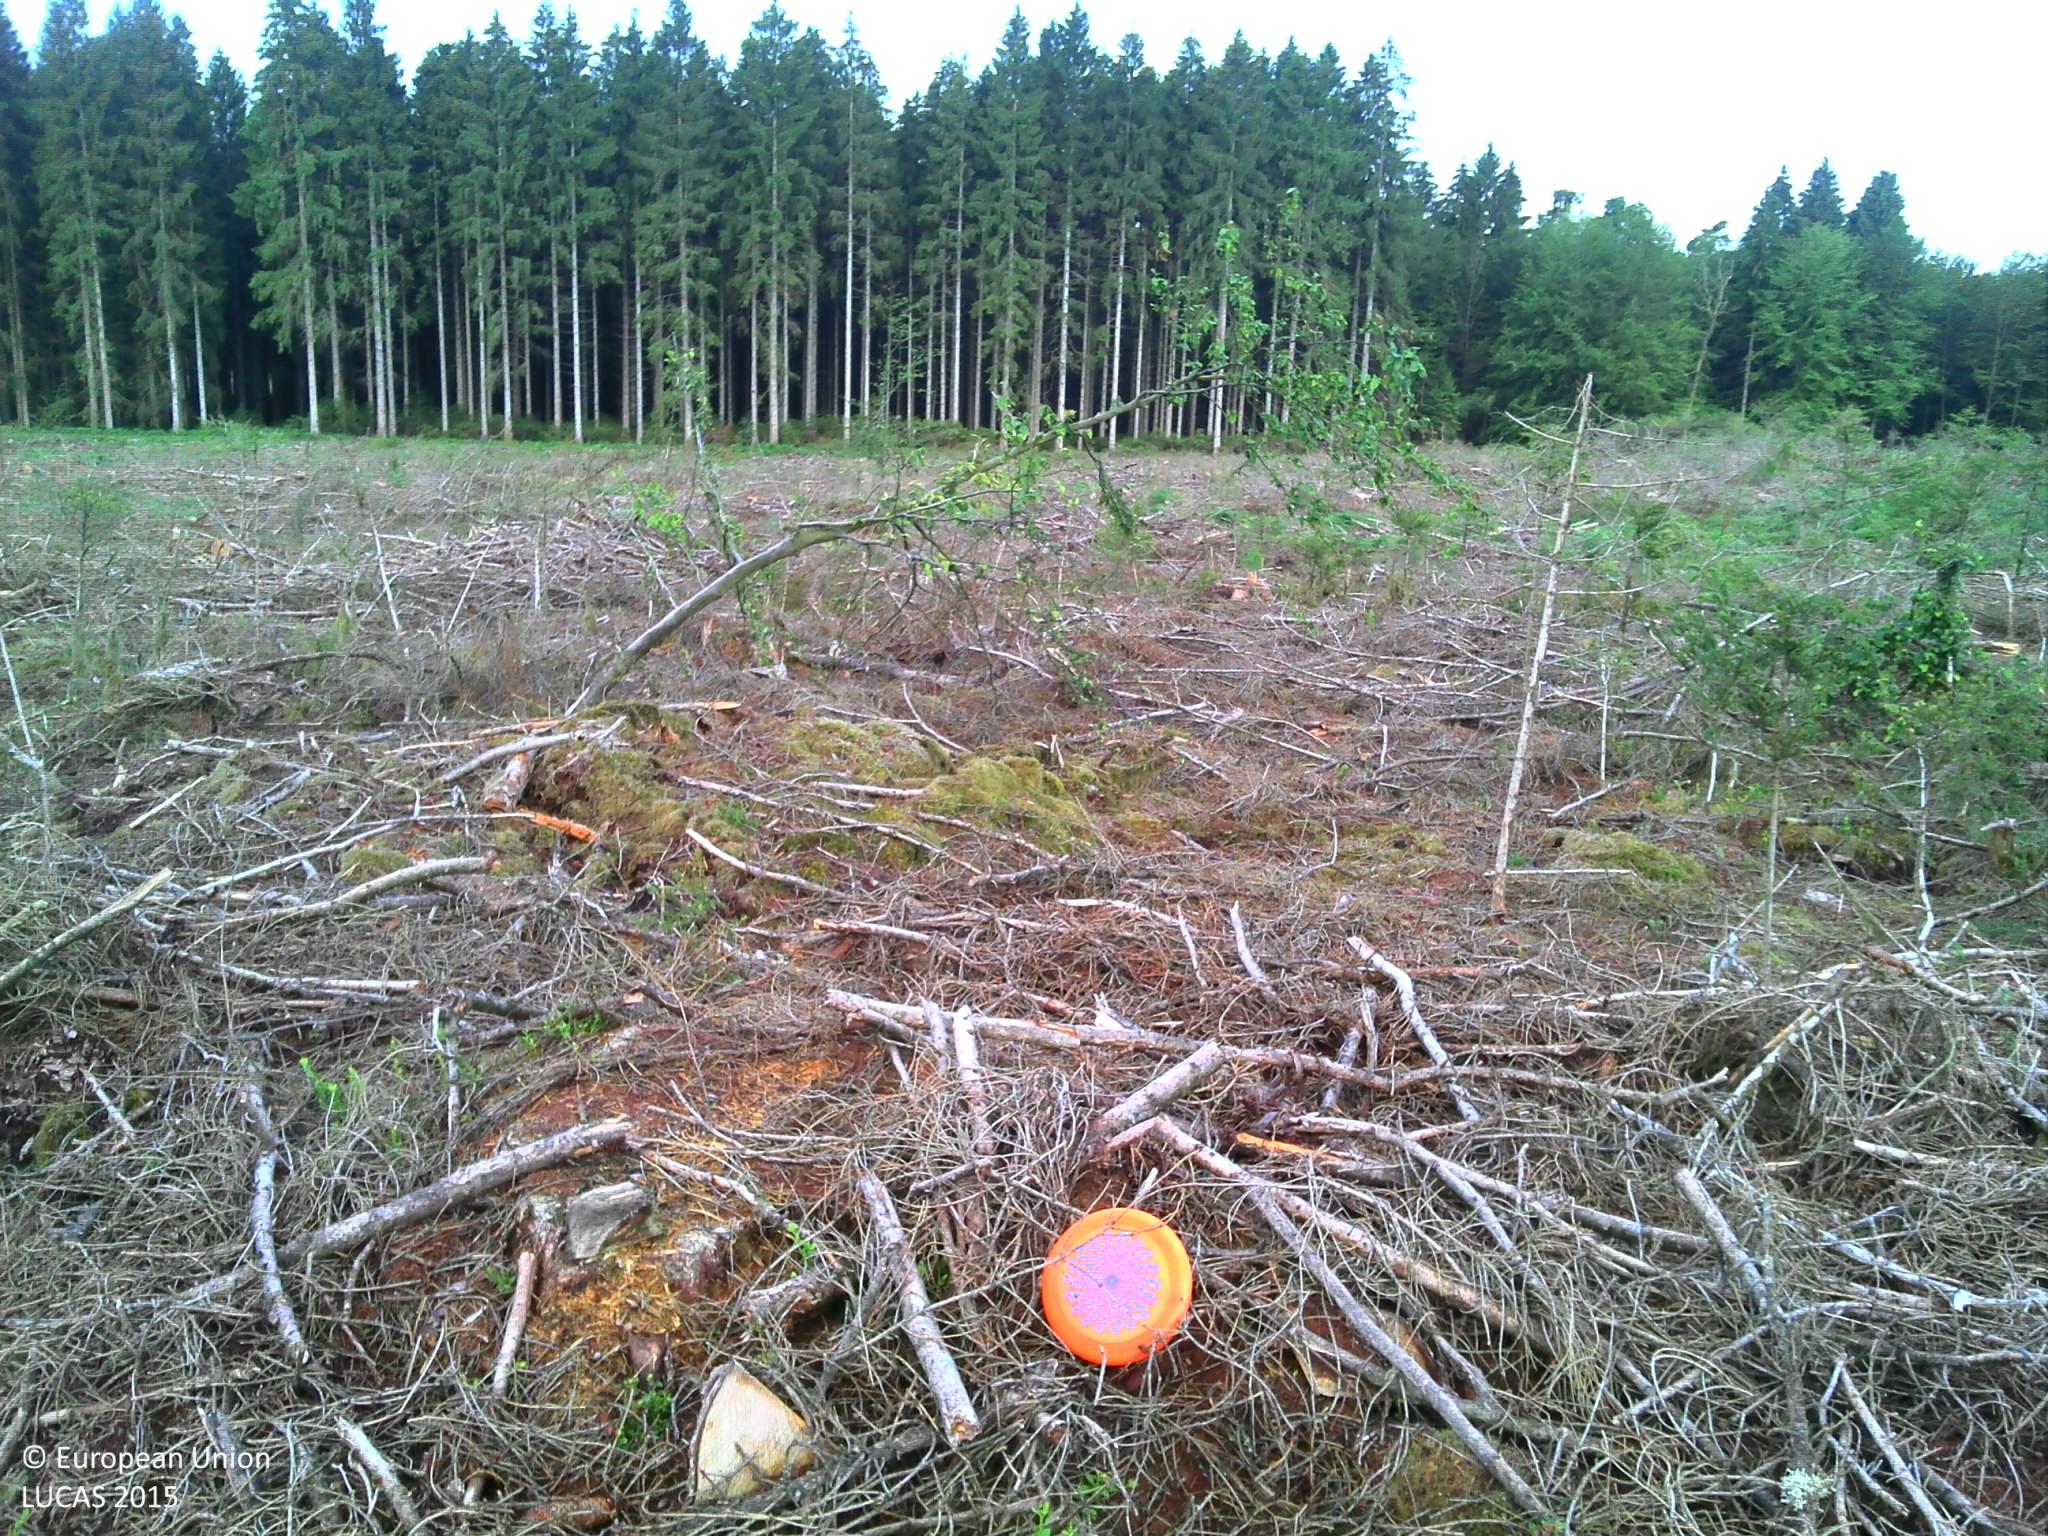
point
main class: Grassland
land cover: Spontaneously vegetated surfaces
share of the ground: 50 - 75 %
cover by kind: herbaceous plants 65 %, unconsolidated bare surface 30 %, shrubs 5 %
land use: Forestry
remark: Clear cut
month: July
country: BE
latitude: 49.7639
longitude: 5.3195
